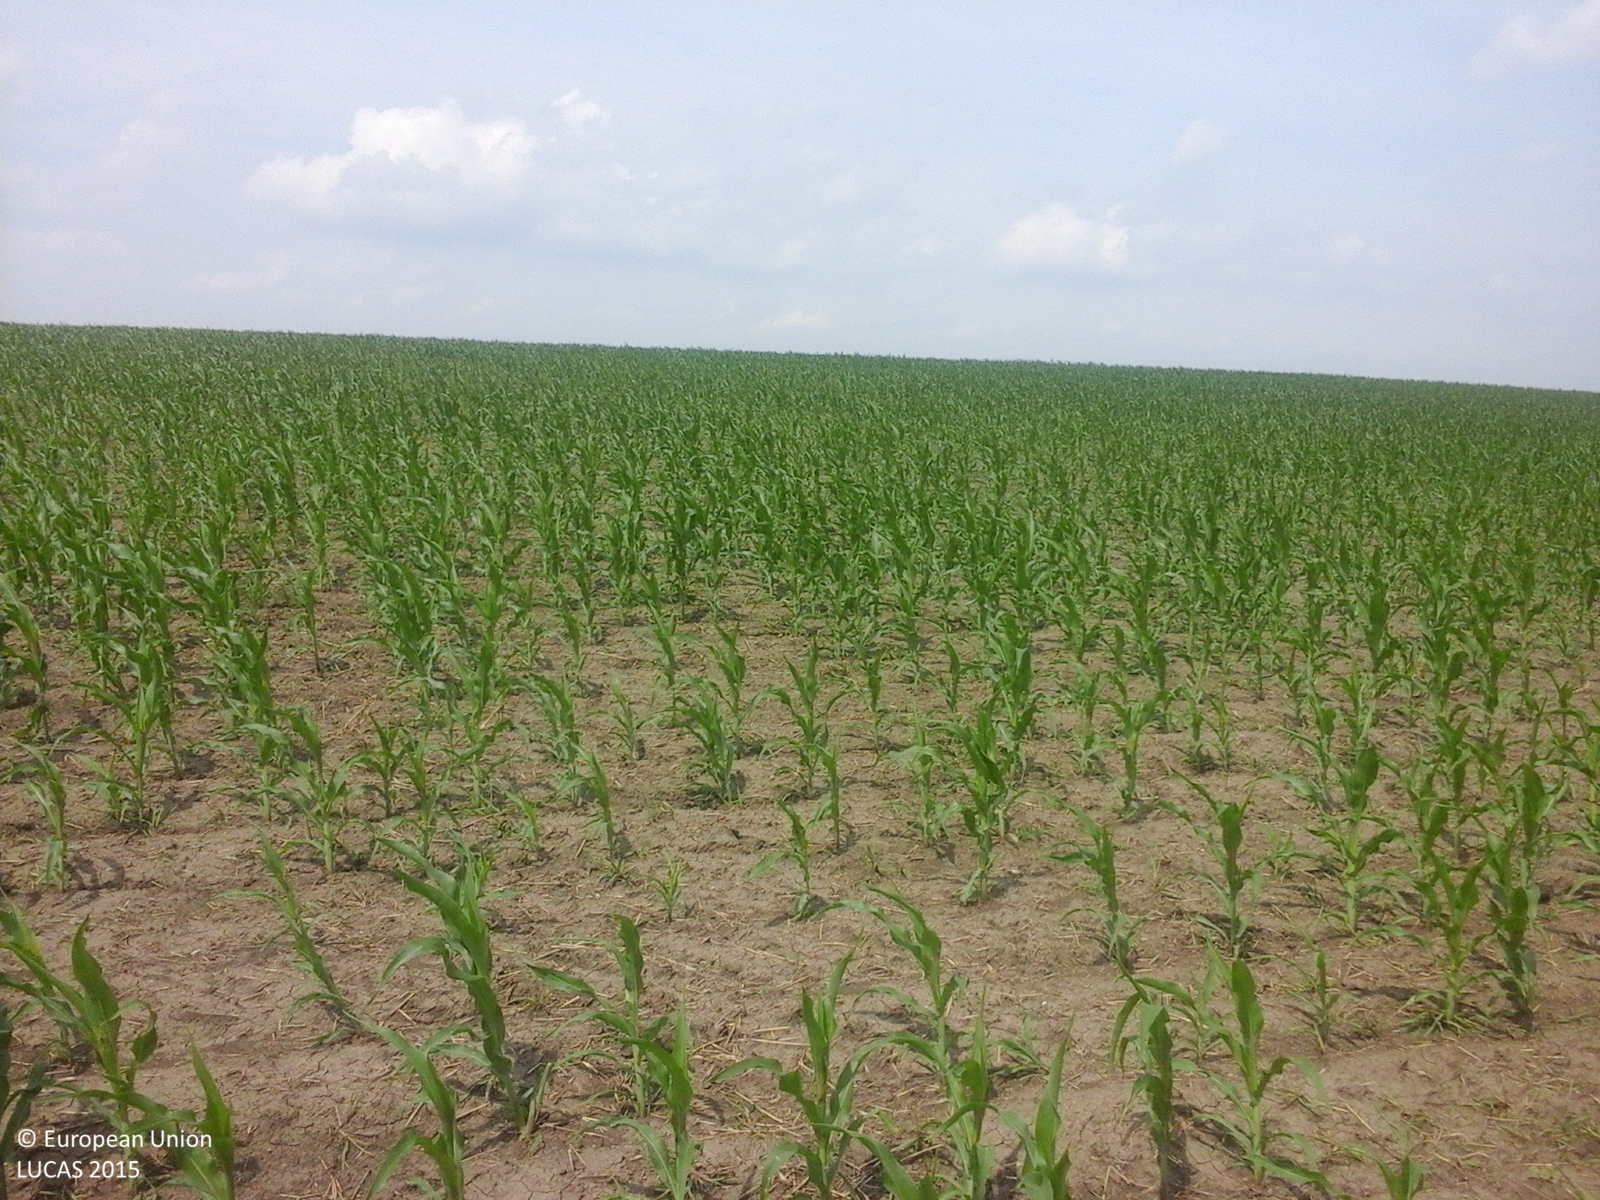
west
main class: Cropland
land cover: Maize
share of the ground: 50 - 75 %
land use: Agriculture (excluding fallow land and kitchen gardens)
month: June
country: RO
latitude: 47.4011
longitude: 27.0239
